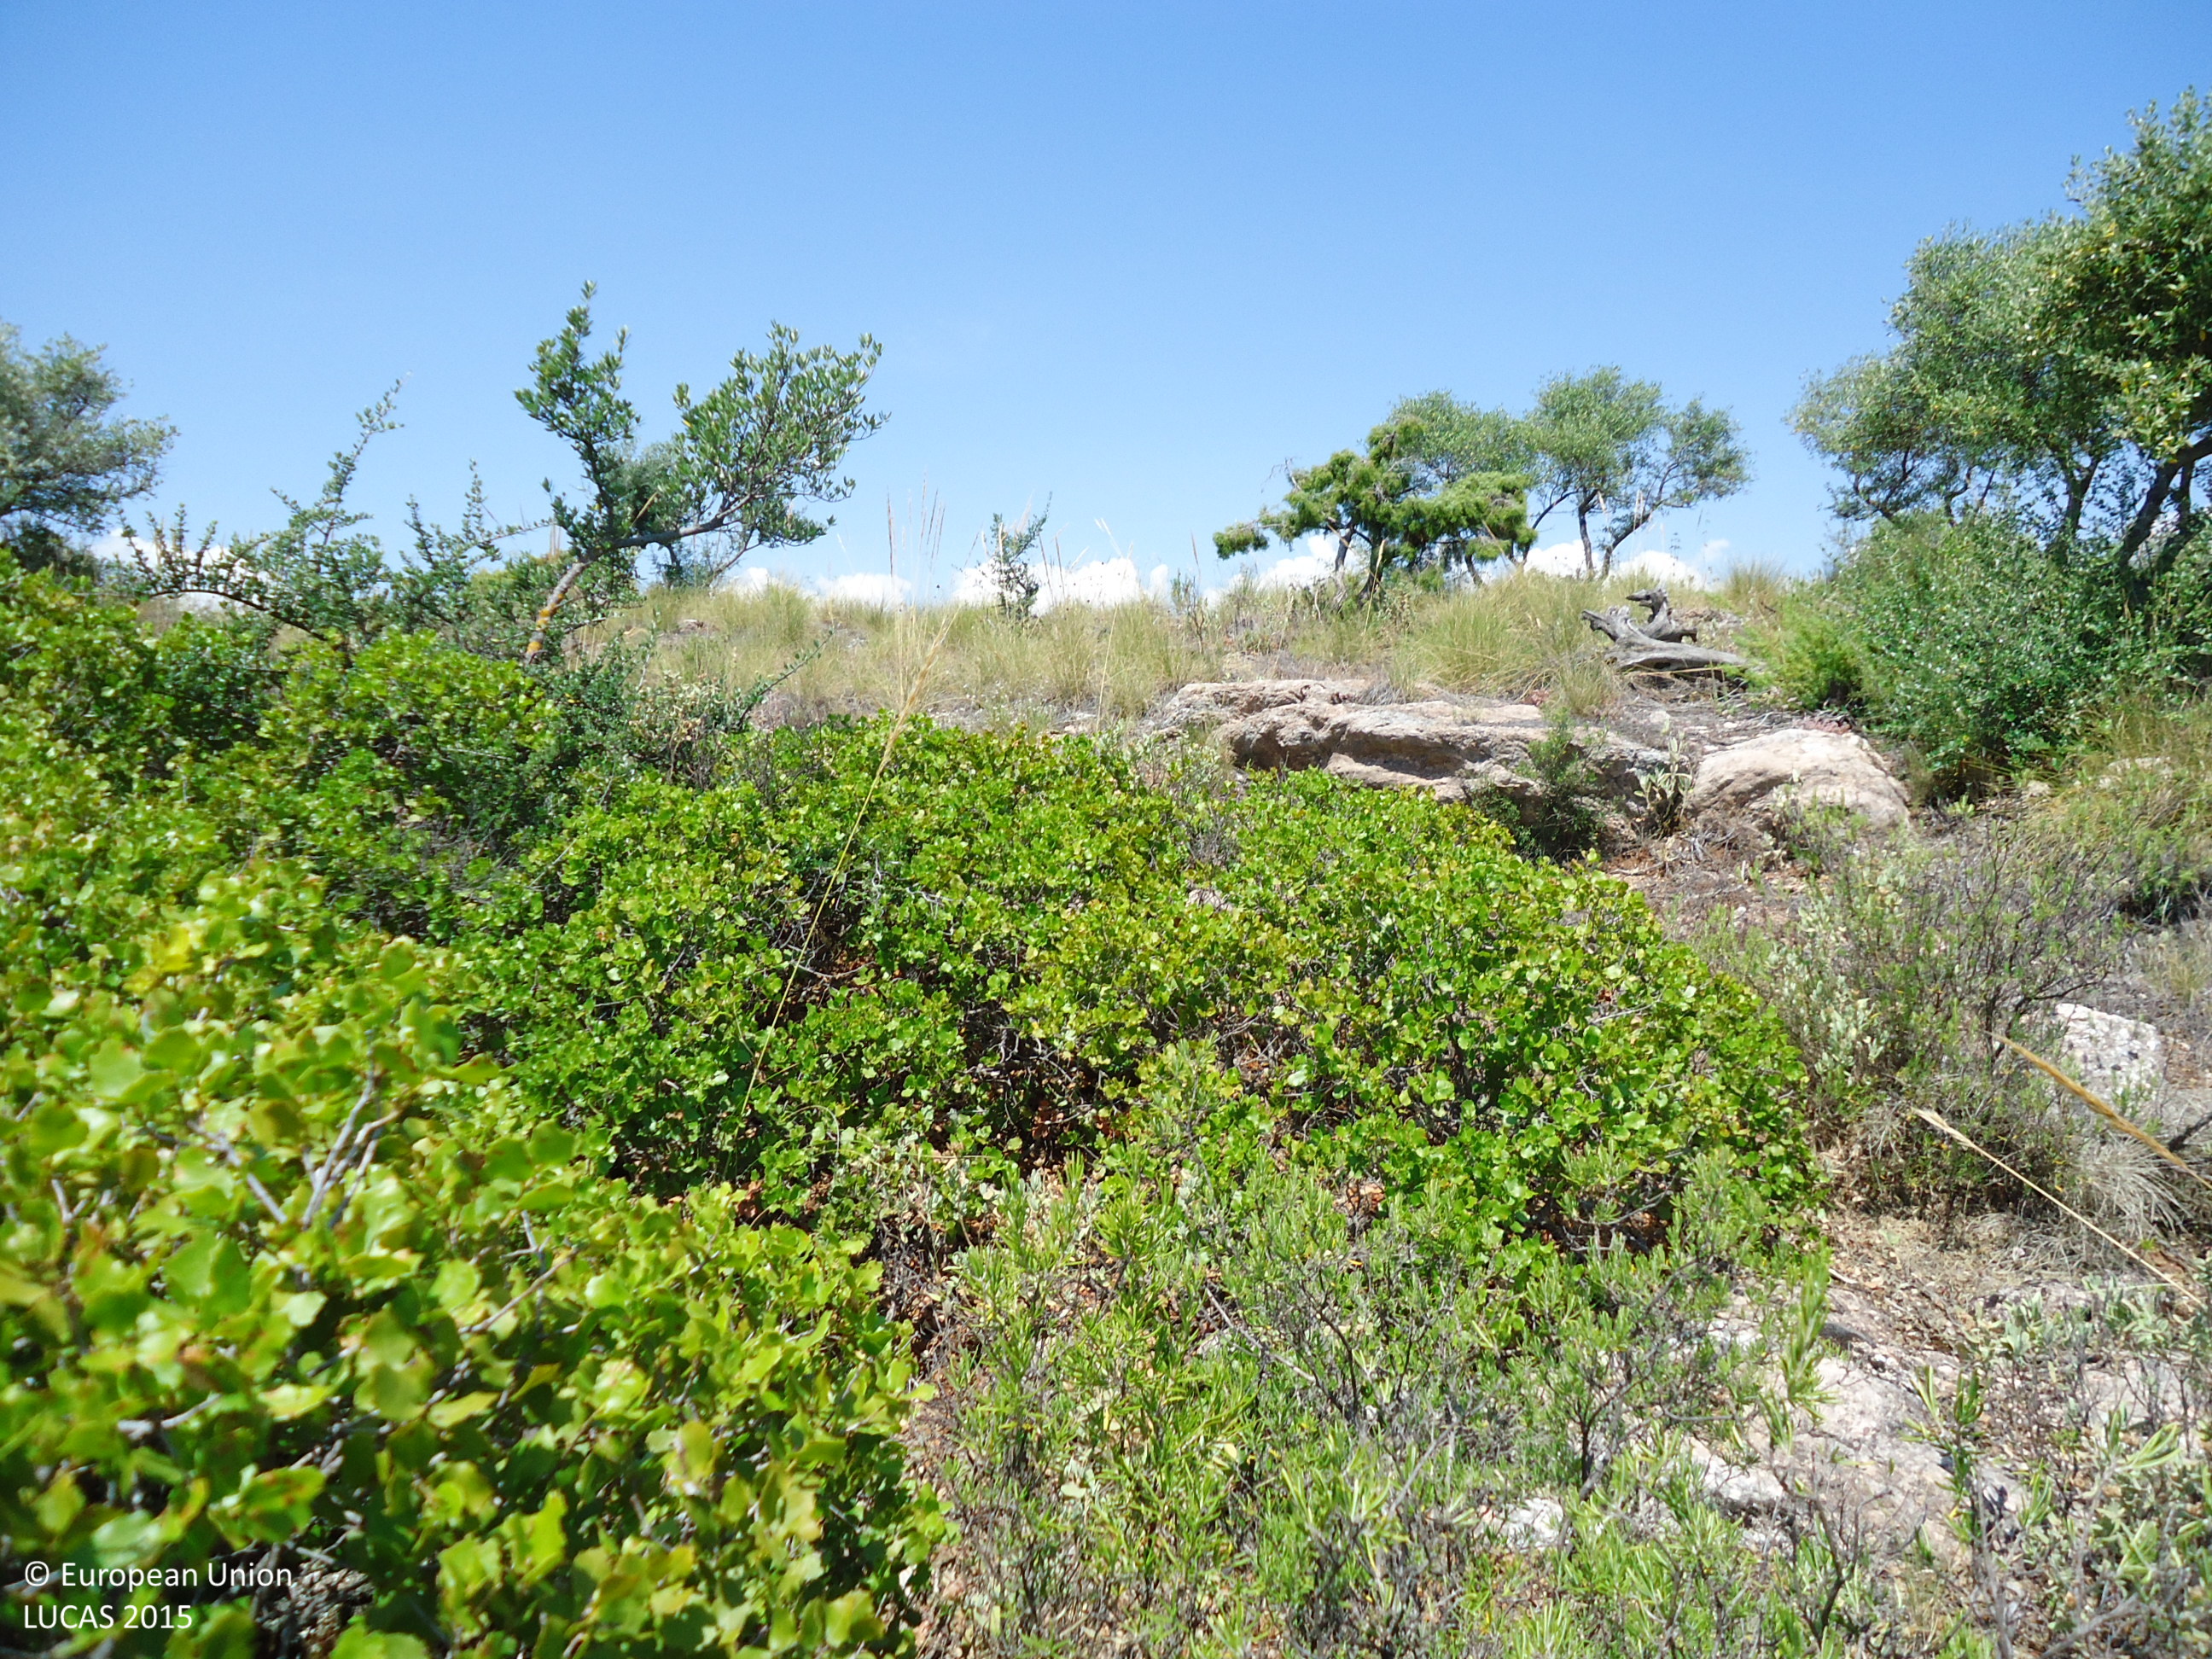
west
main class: Shrubland
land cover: Shrubland with sparse tree cover
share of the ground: > 75 %
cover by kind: shrubs 90 %, broadleaved forest trees 5 %, consolidated bare surface 5 %
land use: Semi-natural and natural areas not in use
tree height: < 5 m
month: June
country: ES
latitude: 36.7786
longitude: -4.9553
